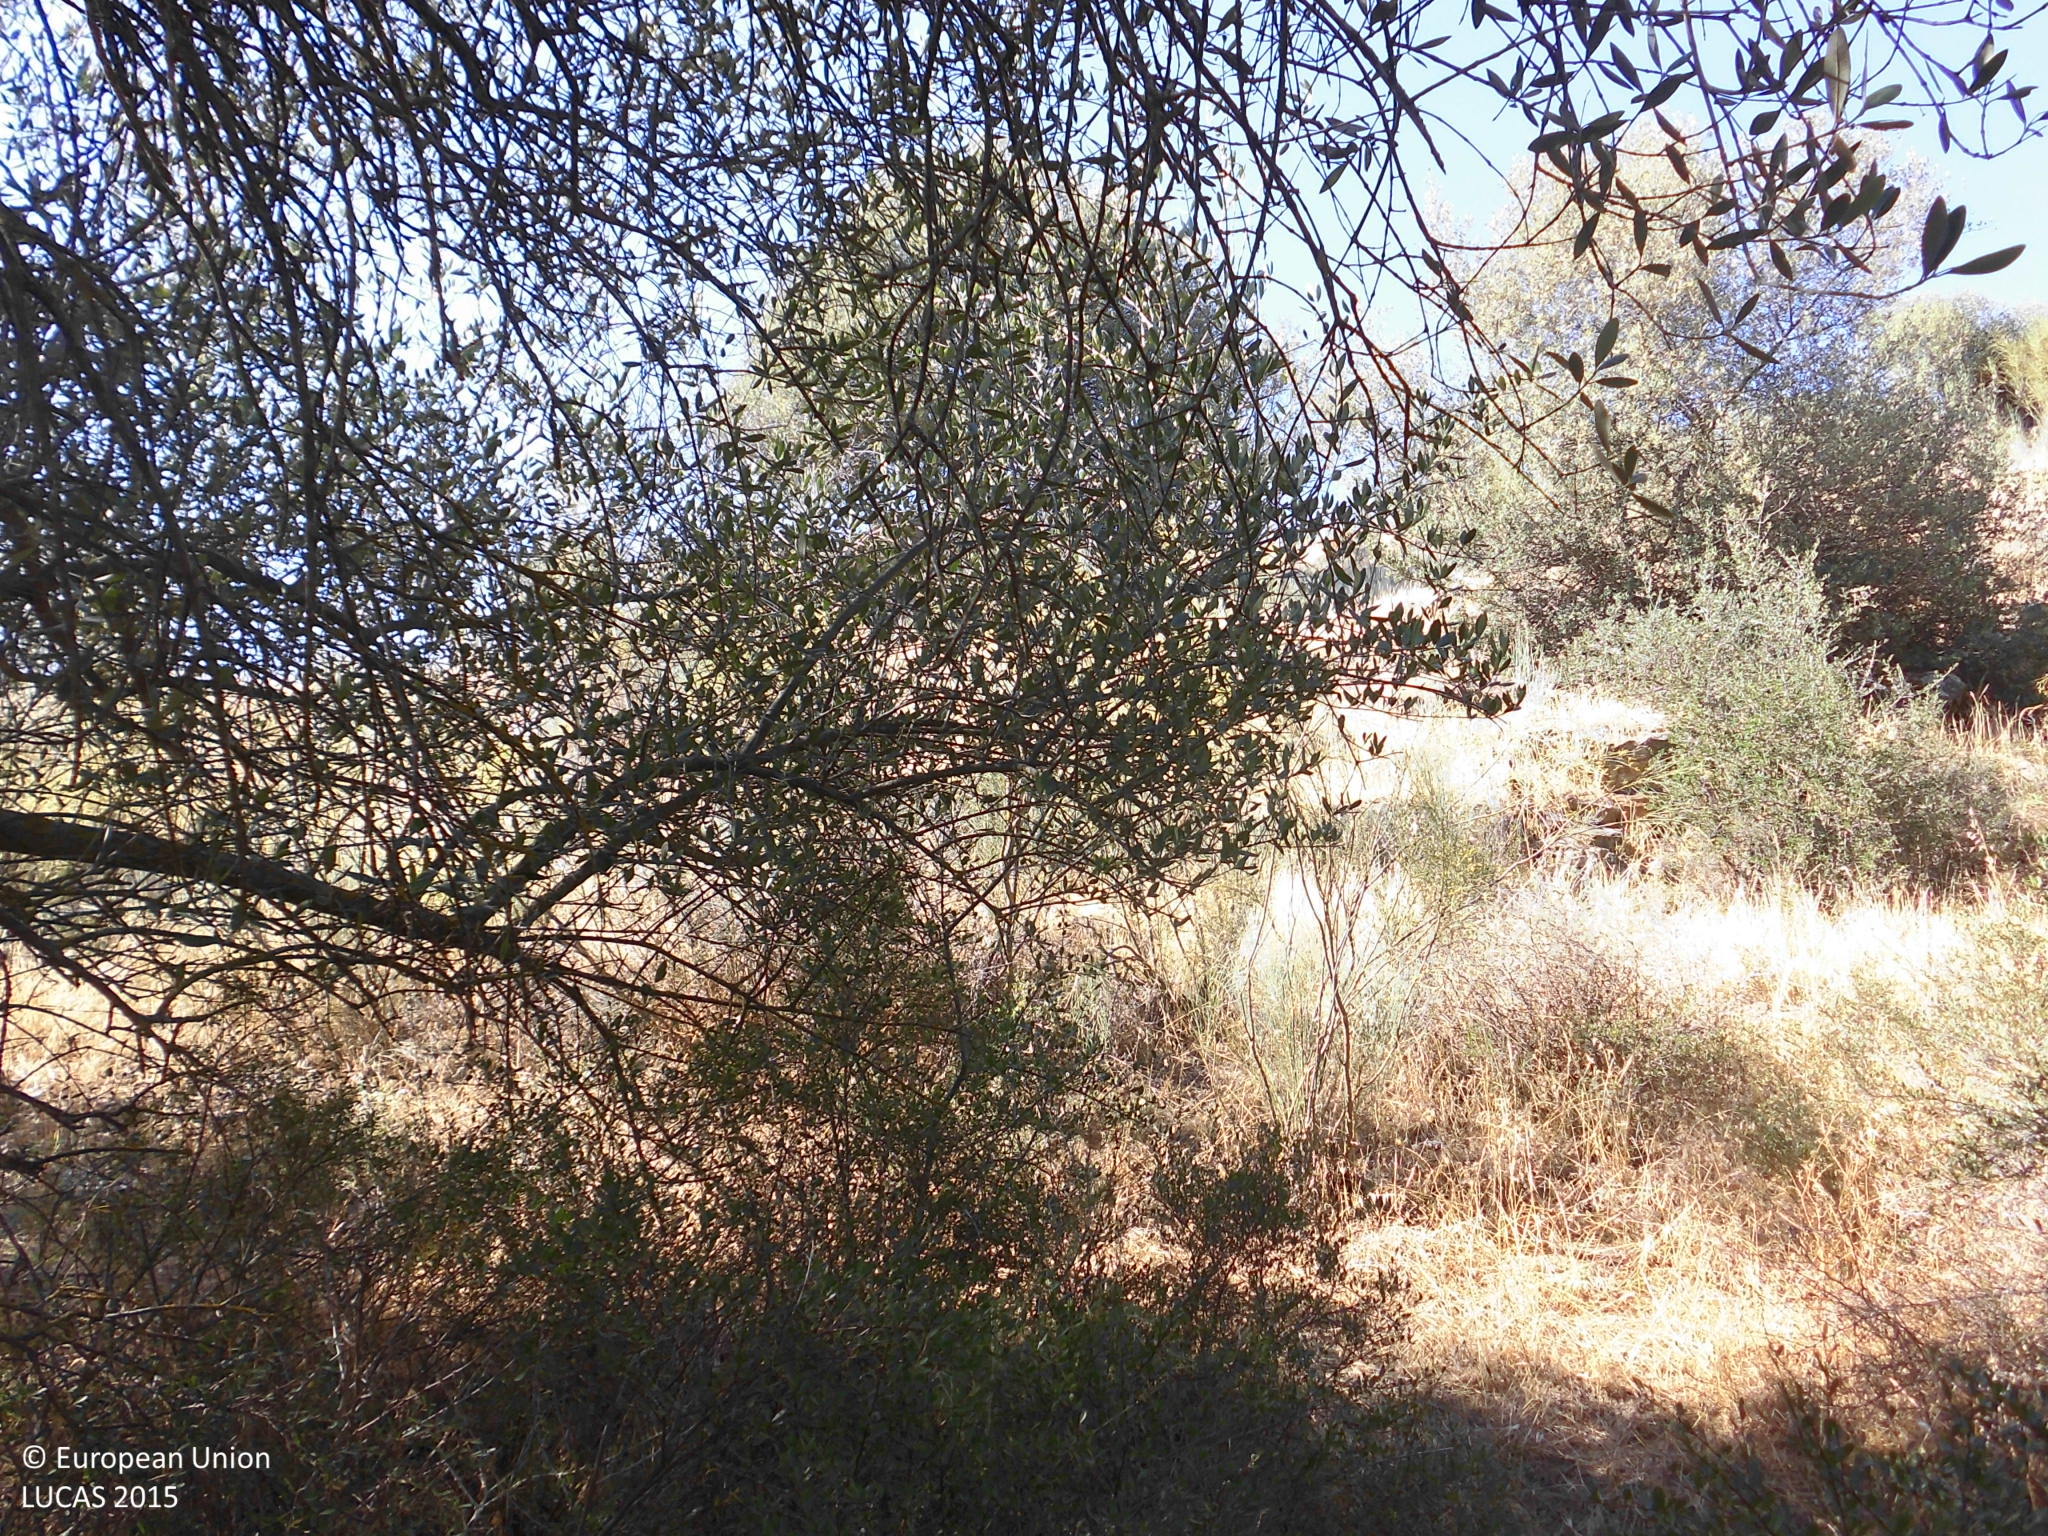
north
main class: Woodland
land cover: Broadleaved woodland
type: thermophilous deciduous forest
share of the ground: 25 - 50 %
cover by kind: broadleaved forest trees 50 %, shrubs 40 %, herbaceous plants 10 %
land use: Semi-natural and natural areas not in use
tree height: > 5 m
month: June
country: ES
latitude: 39.7347
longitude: -6.4444
